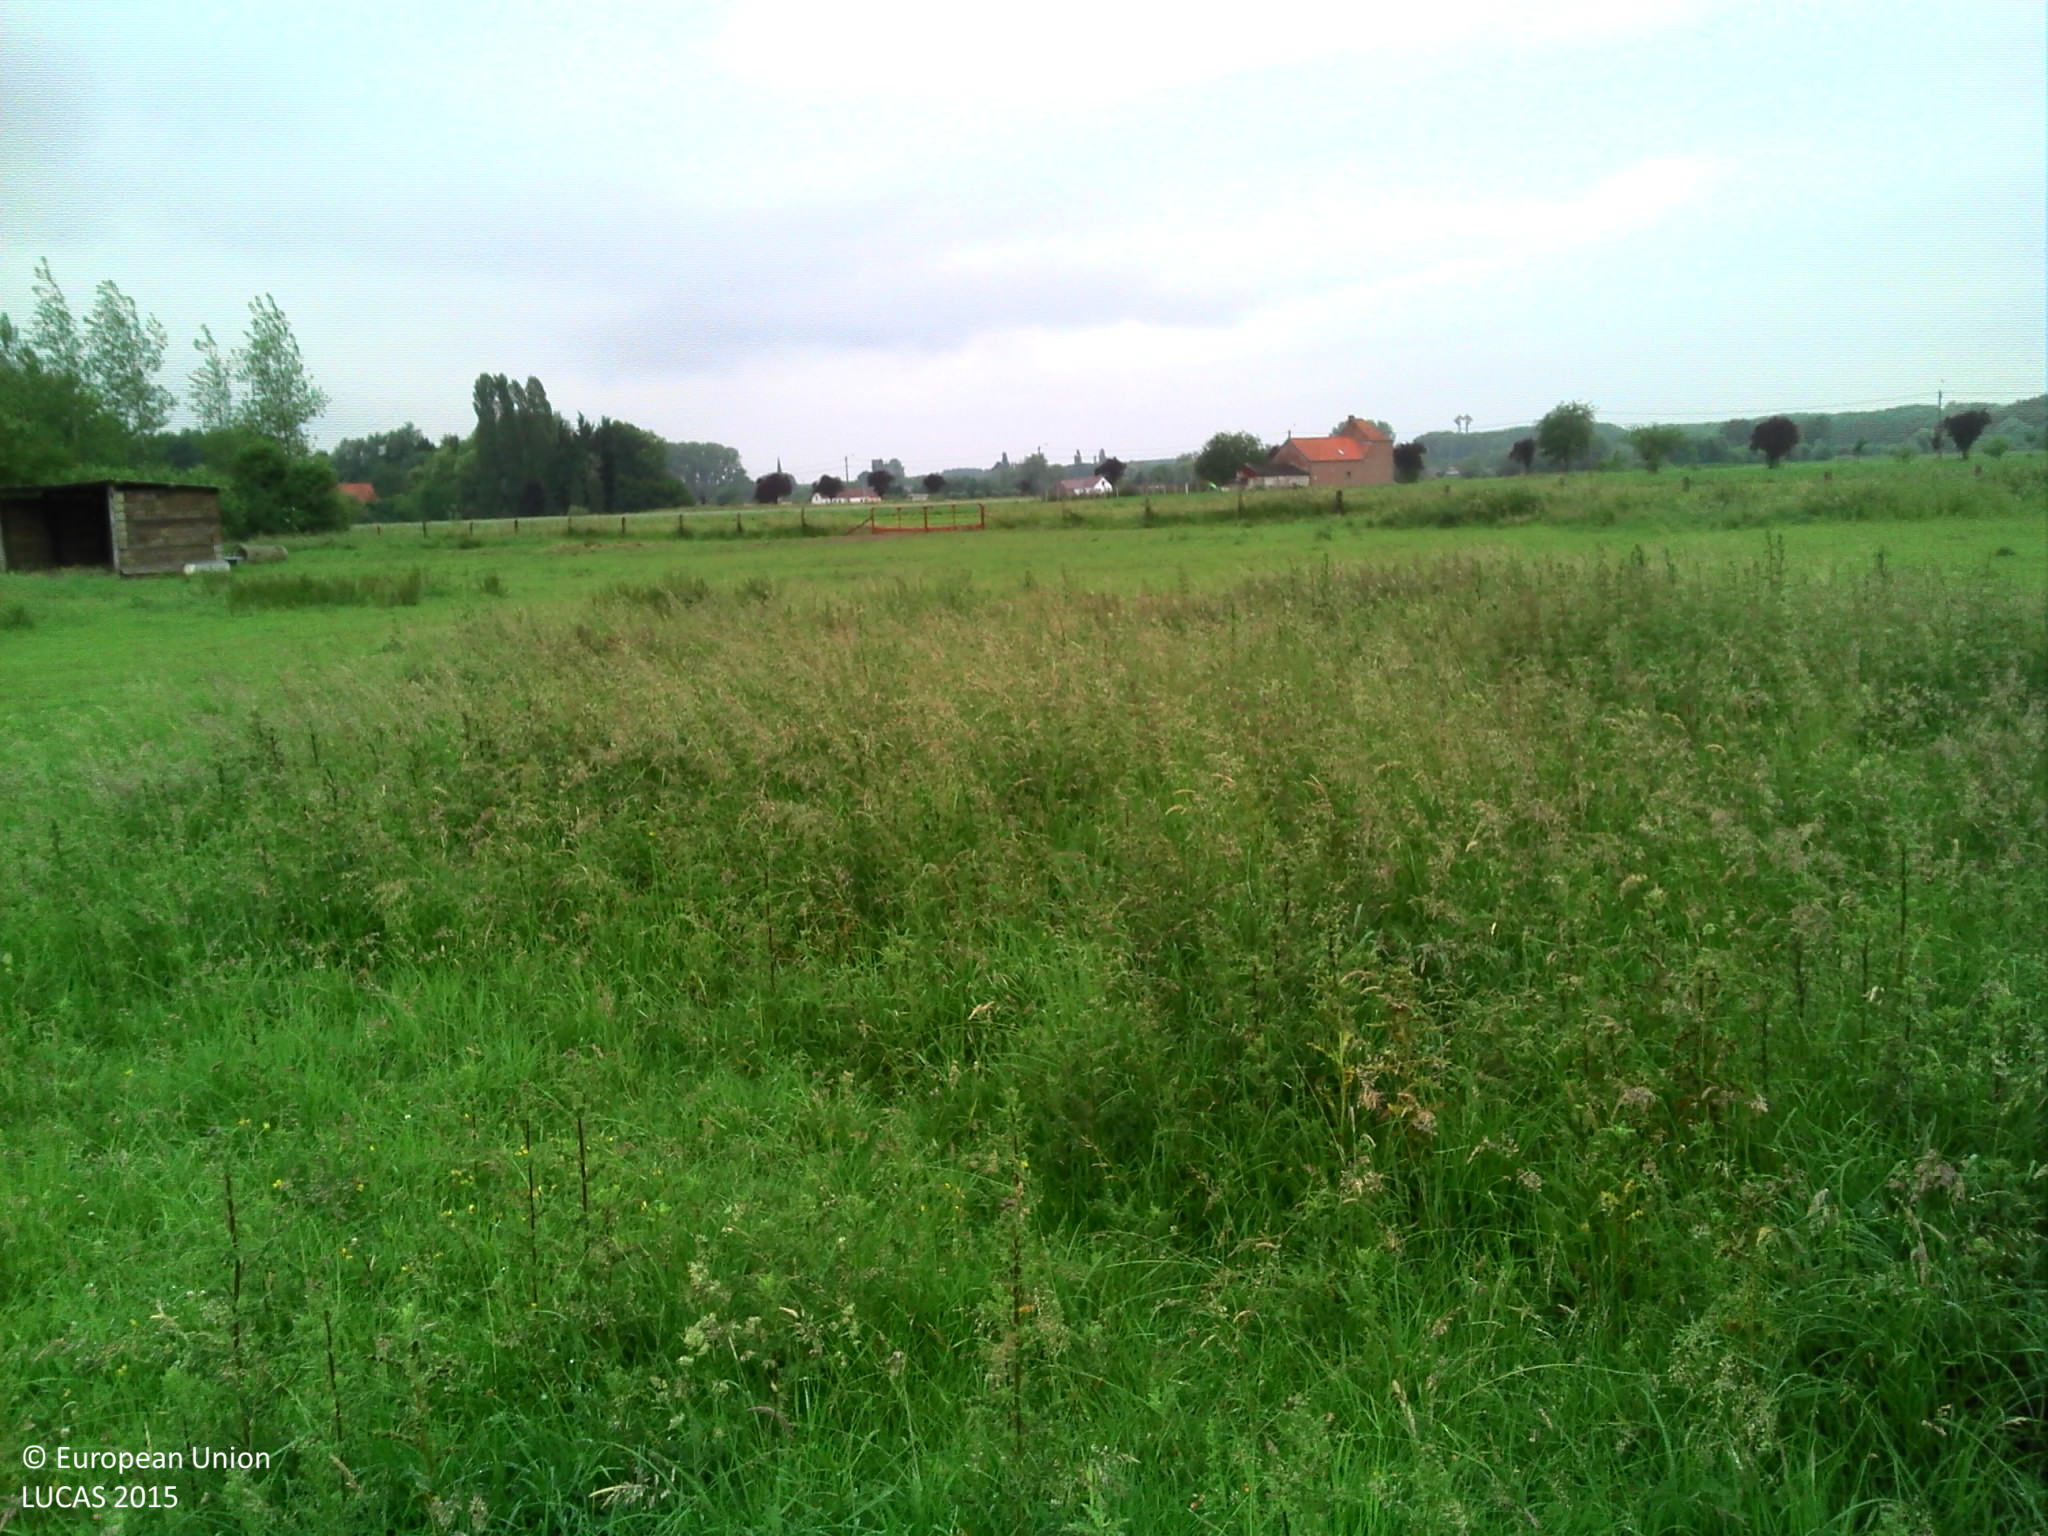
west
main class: Grassland
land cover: Grassland without tree/shrub cover
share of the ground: > 75 %
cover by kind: herbaceous plants 100 %
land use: Agriculture (excluding fallow land and kitchen gardens)
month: June
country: BE
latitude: 50.4428
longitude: 3.6988
